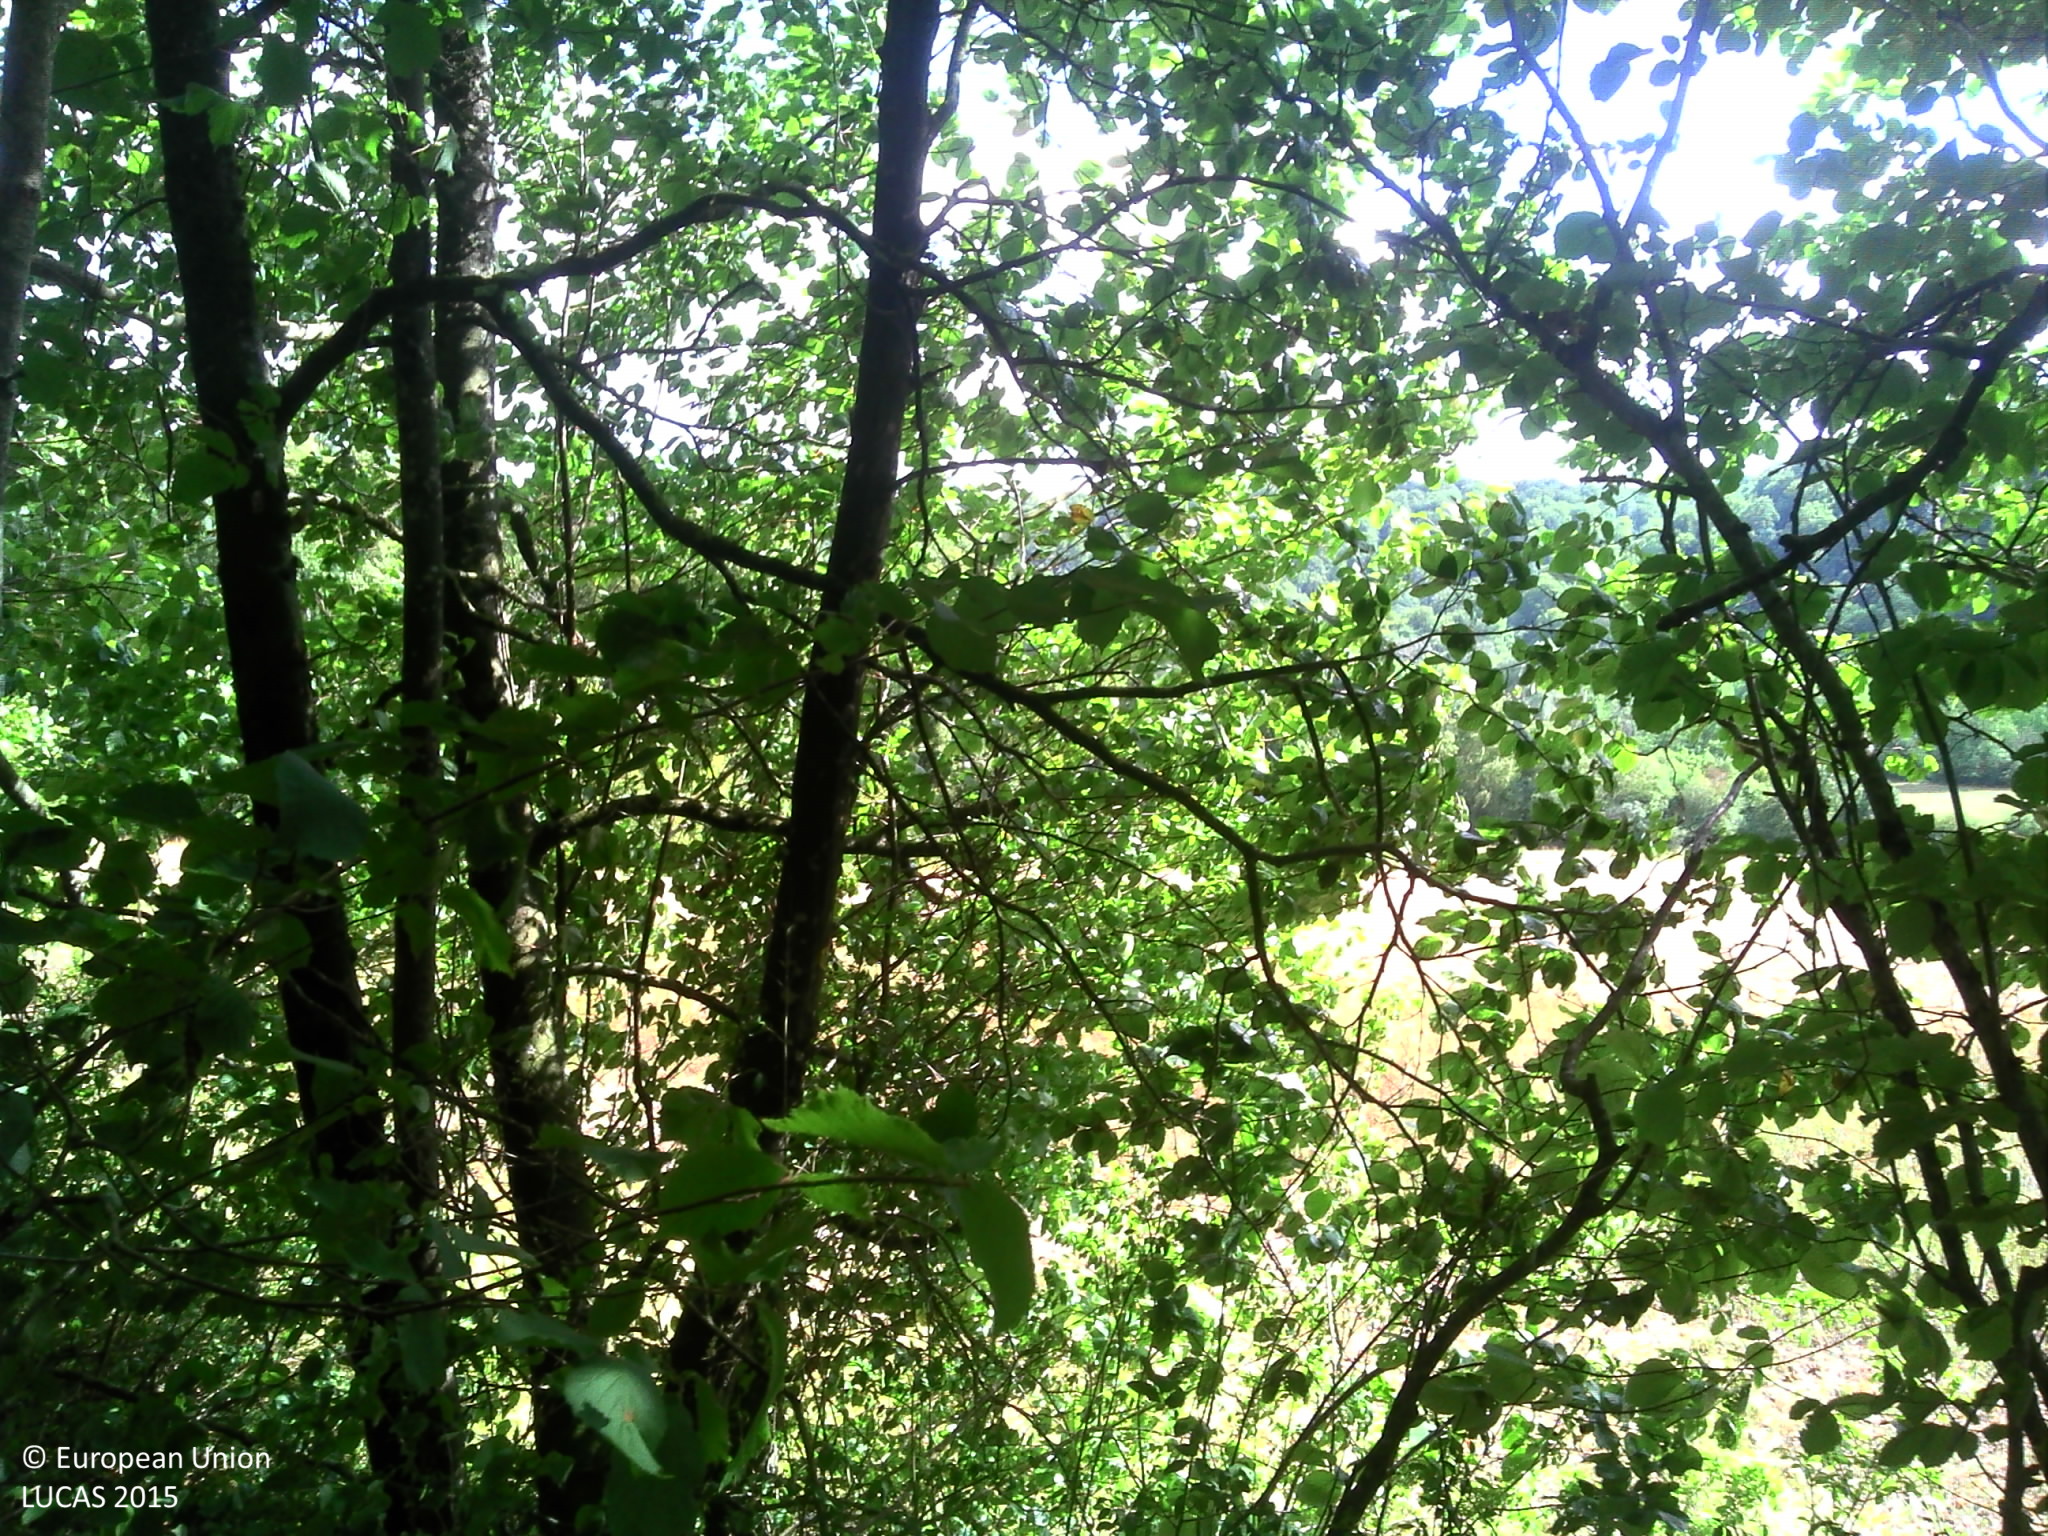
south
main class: Woodland
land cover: Broadleaved woodland
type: acidophilous oak and oak-birch forest
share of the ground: > 75 %
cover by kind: broadleaved forest trees 85 %, coniferous forest trees 5 %, herbaceous plants 5 %, lichens and mosses 5 %
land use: Forestry
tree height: > 5 m
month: July
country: FR
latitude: 47.8918
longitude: 4.9570
